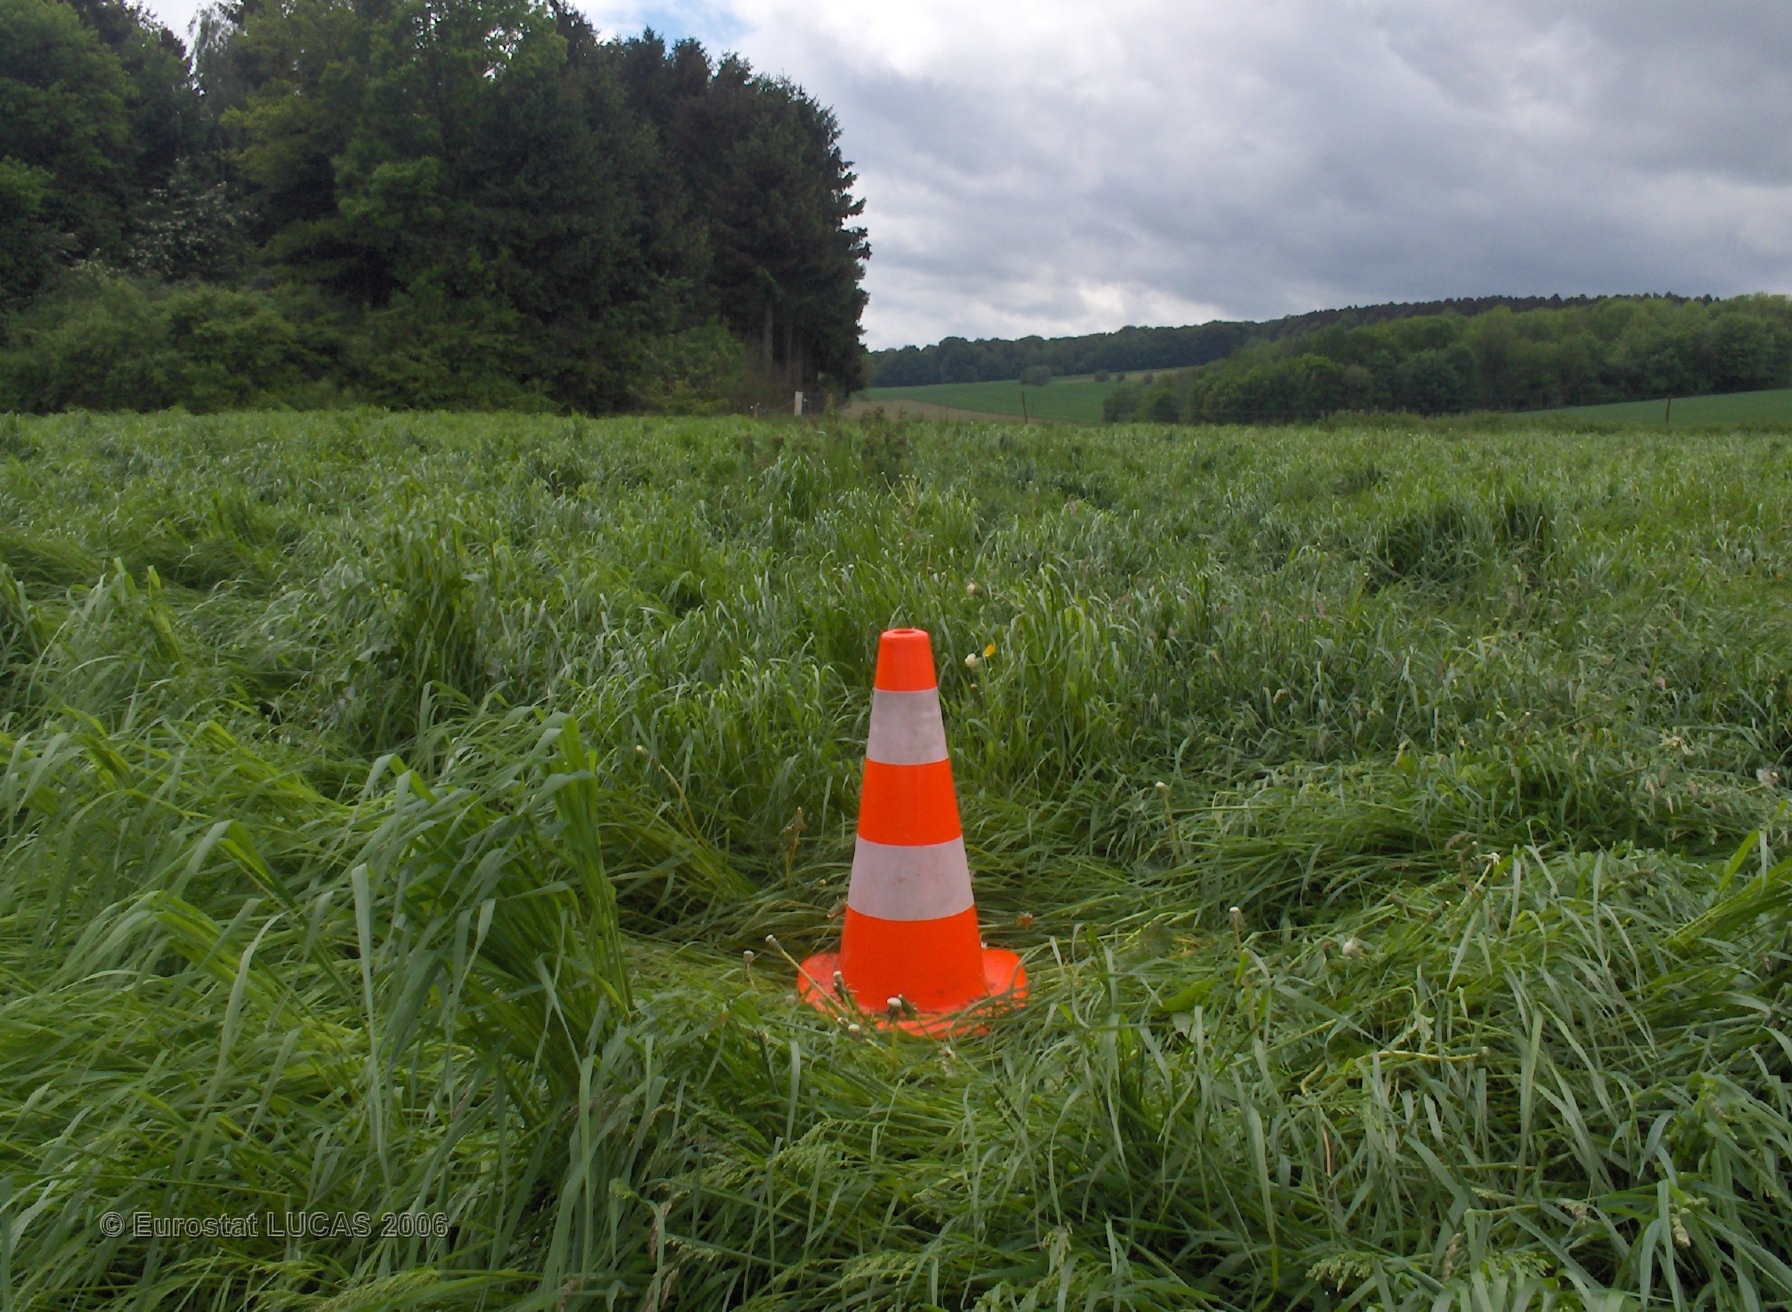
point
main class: Grassland
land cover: Grassland without tree/shrub cover
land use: Agriculture (excluding fallow land and kitchen gardens)
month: May
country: BE
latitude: 50.4109
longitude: 5.2837
